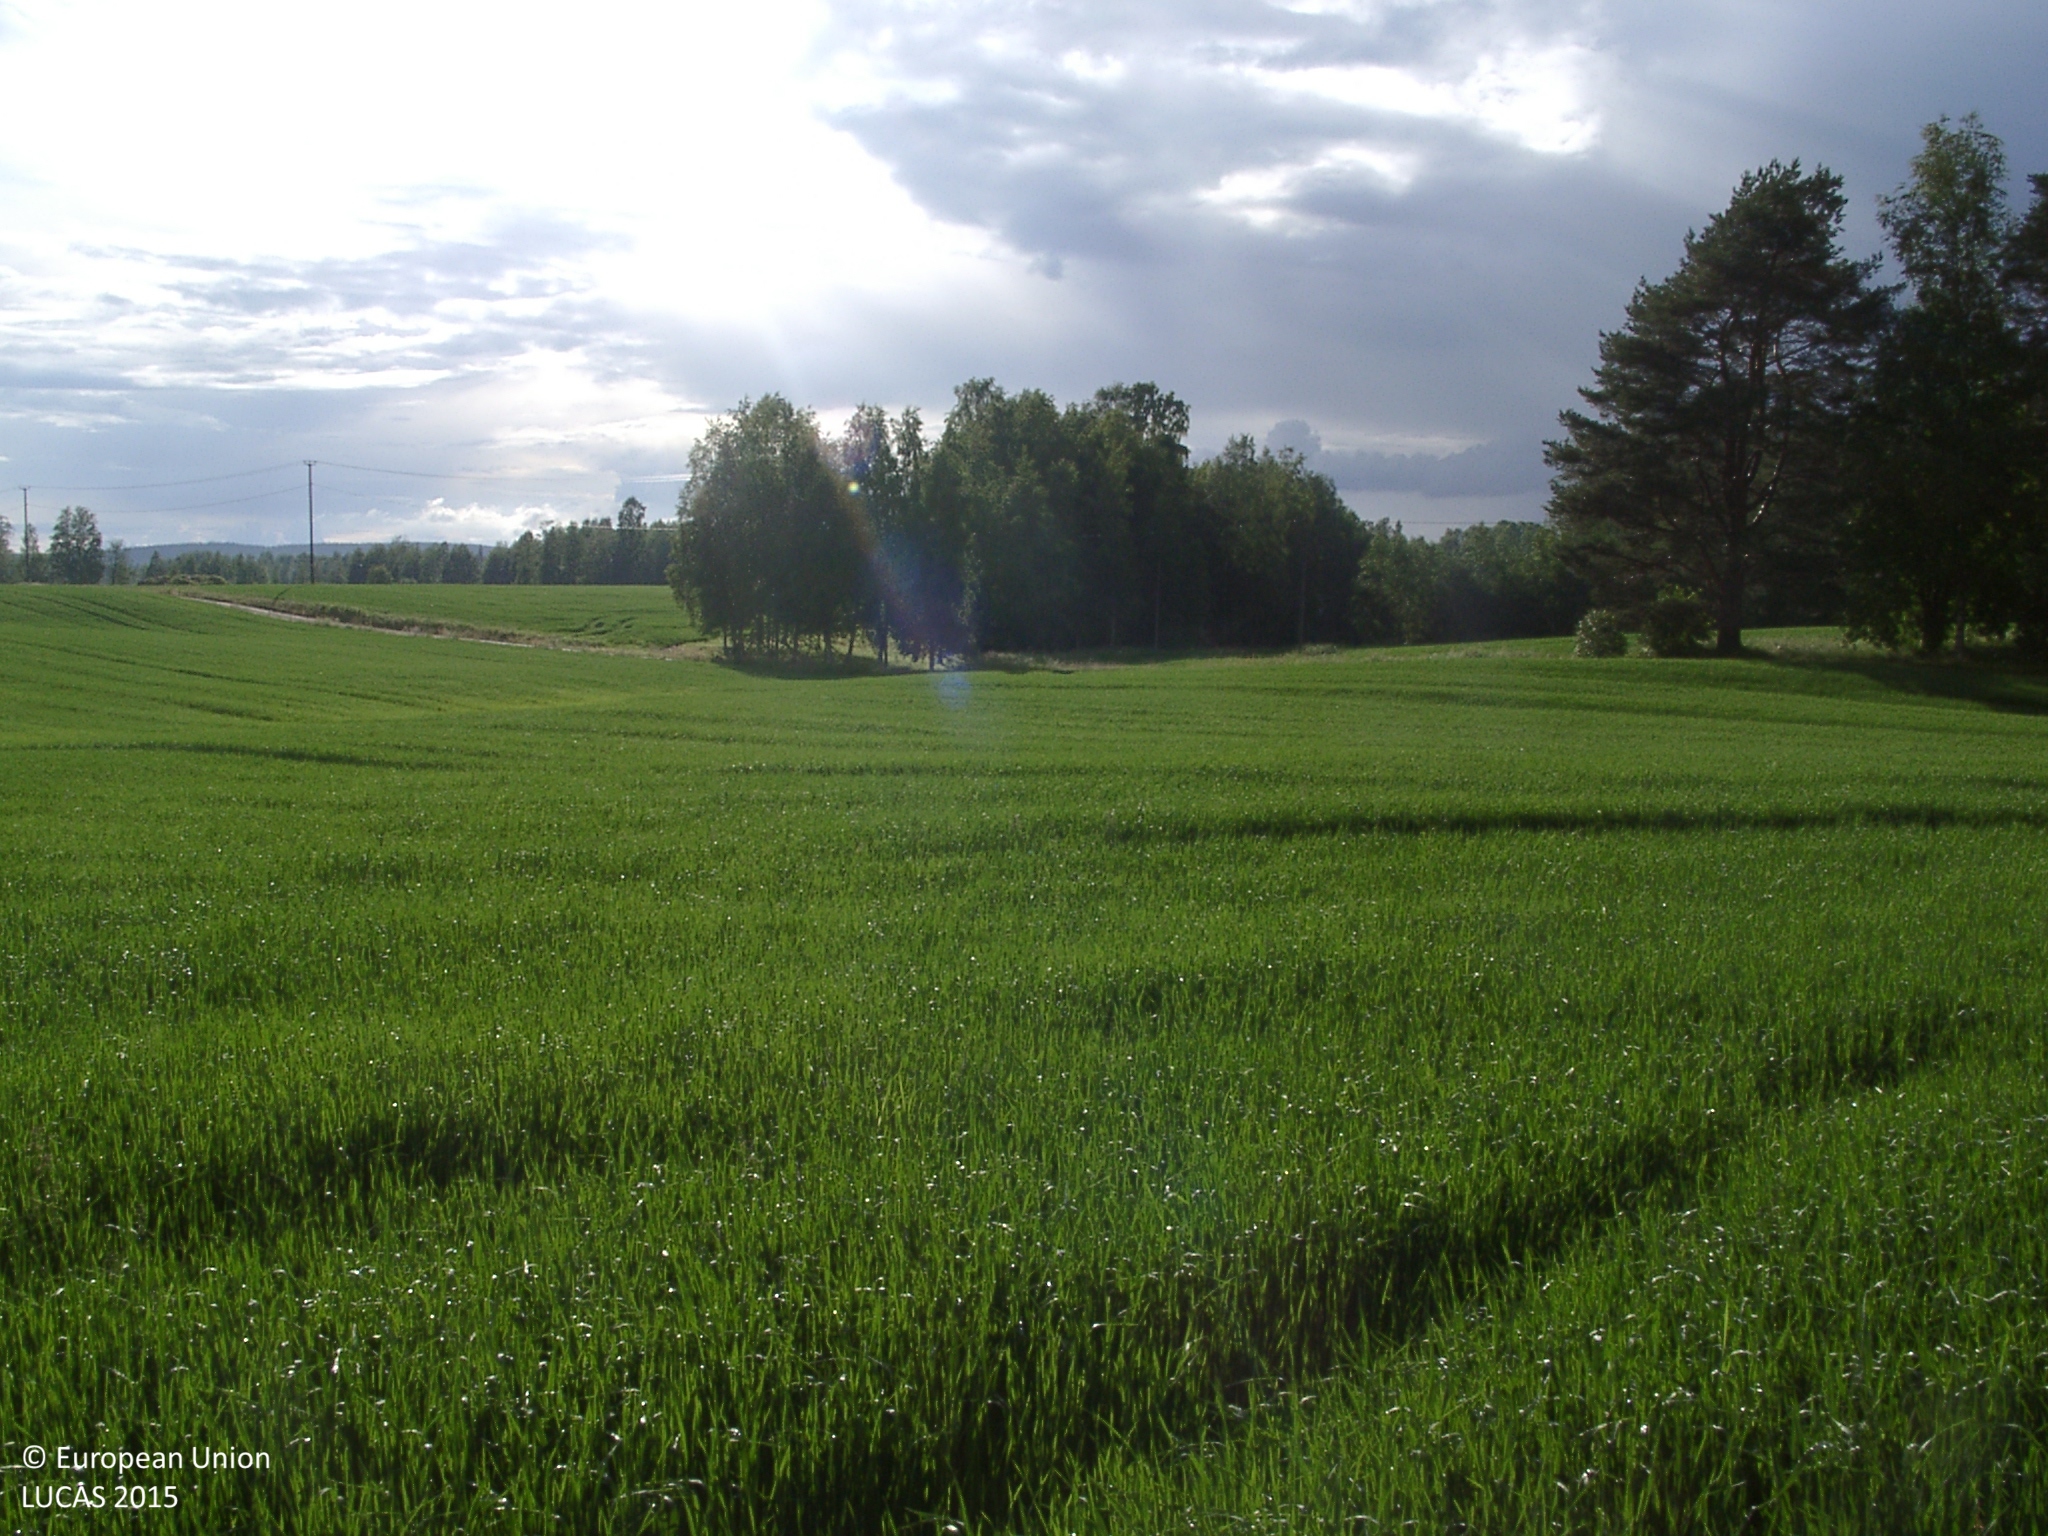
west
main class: Cropland
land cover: Oats
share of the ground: > 75 %
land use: Agriculture (excluding fallow land and kitchen gardens)
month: July
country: FI
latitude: 62.2028
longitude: 25.1965
